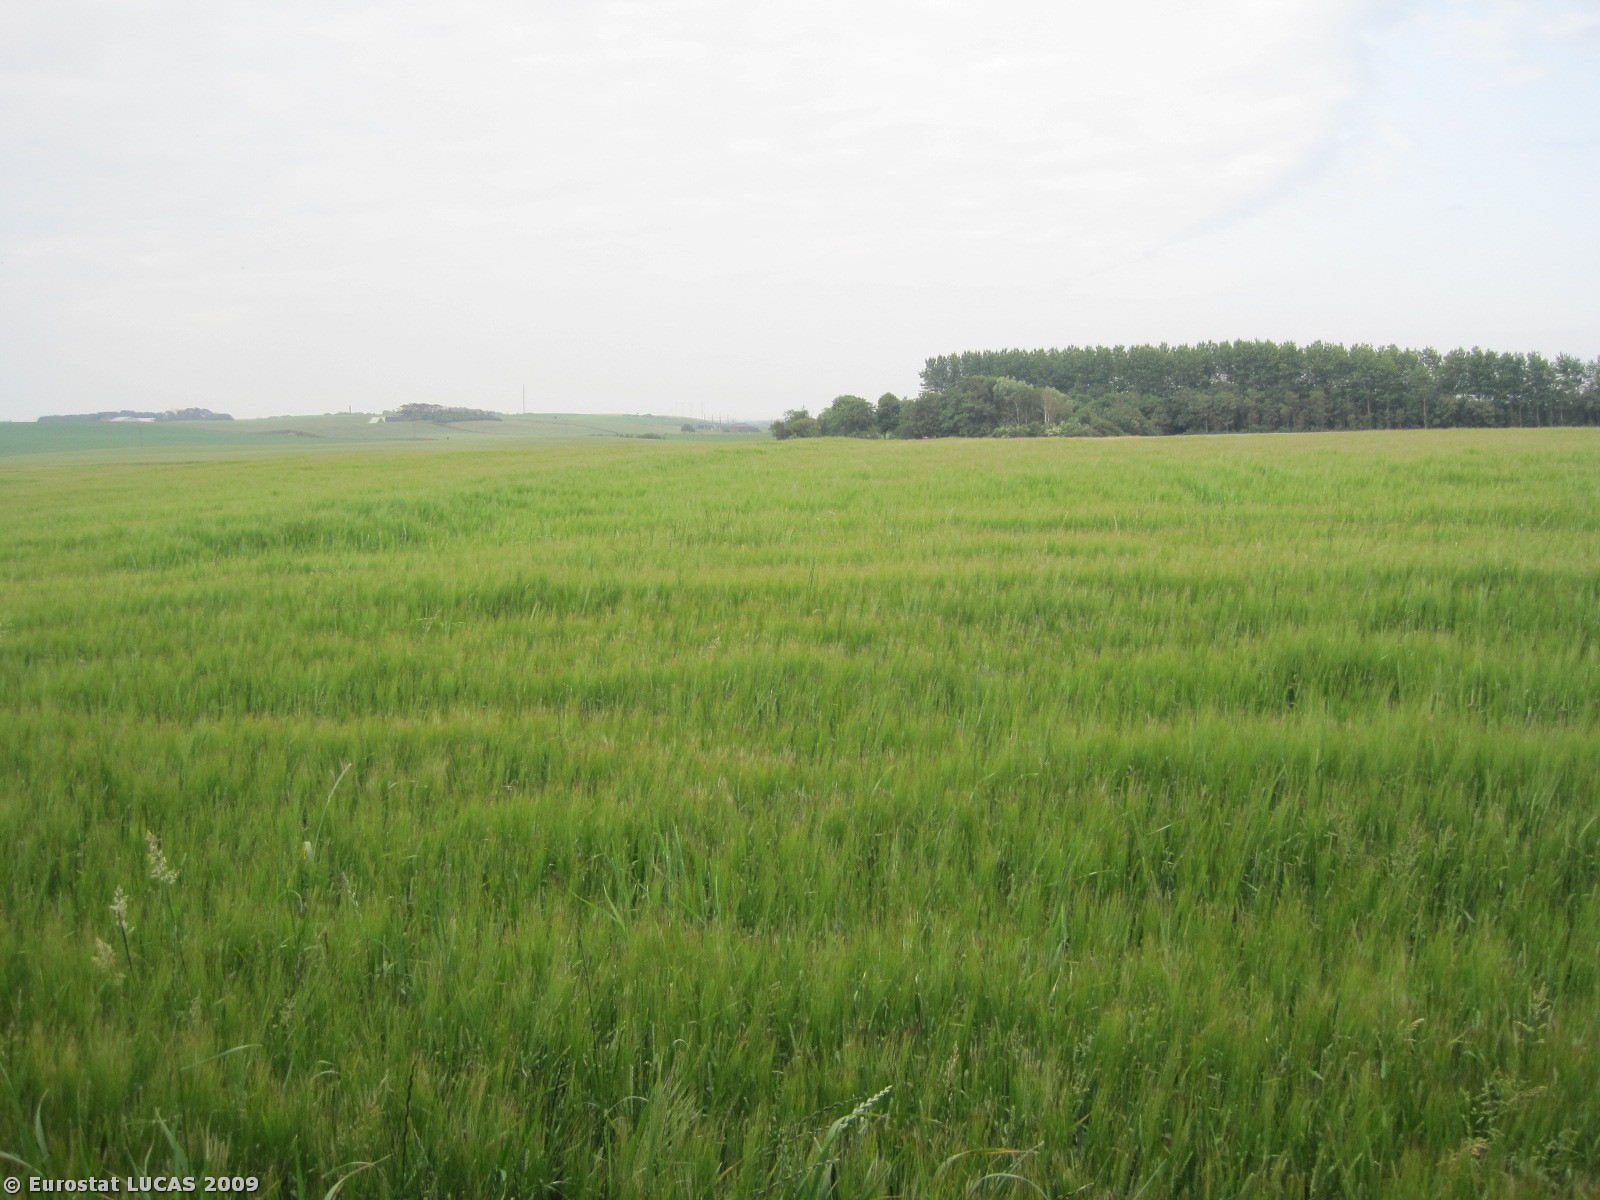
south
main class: Woodland
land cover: Mixed woodland
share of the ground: 50 - 75 %
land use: Residential
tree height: > 5 m
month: June
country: DK
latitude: 56.5557
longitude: 8.4239
